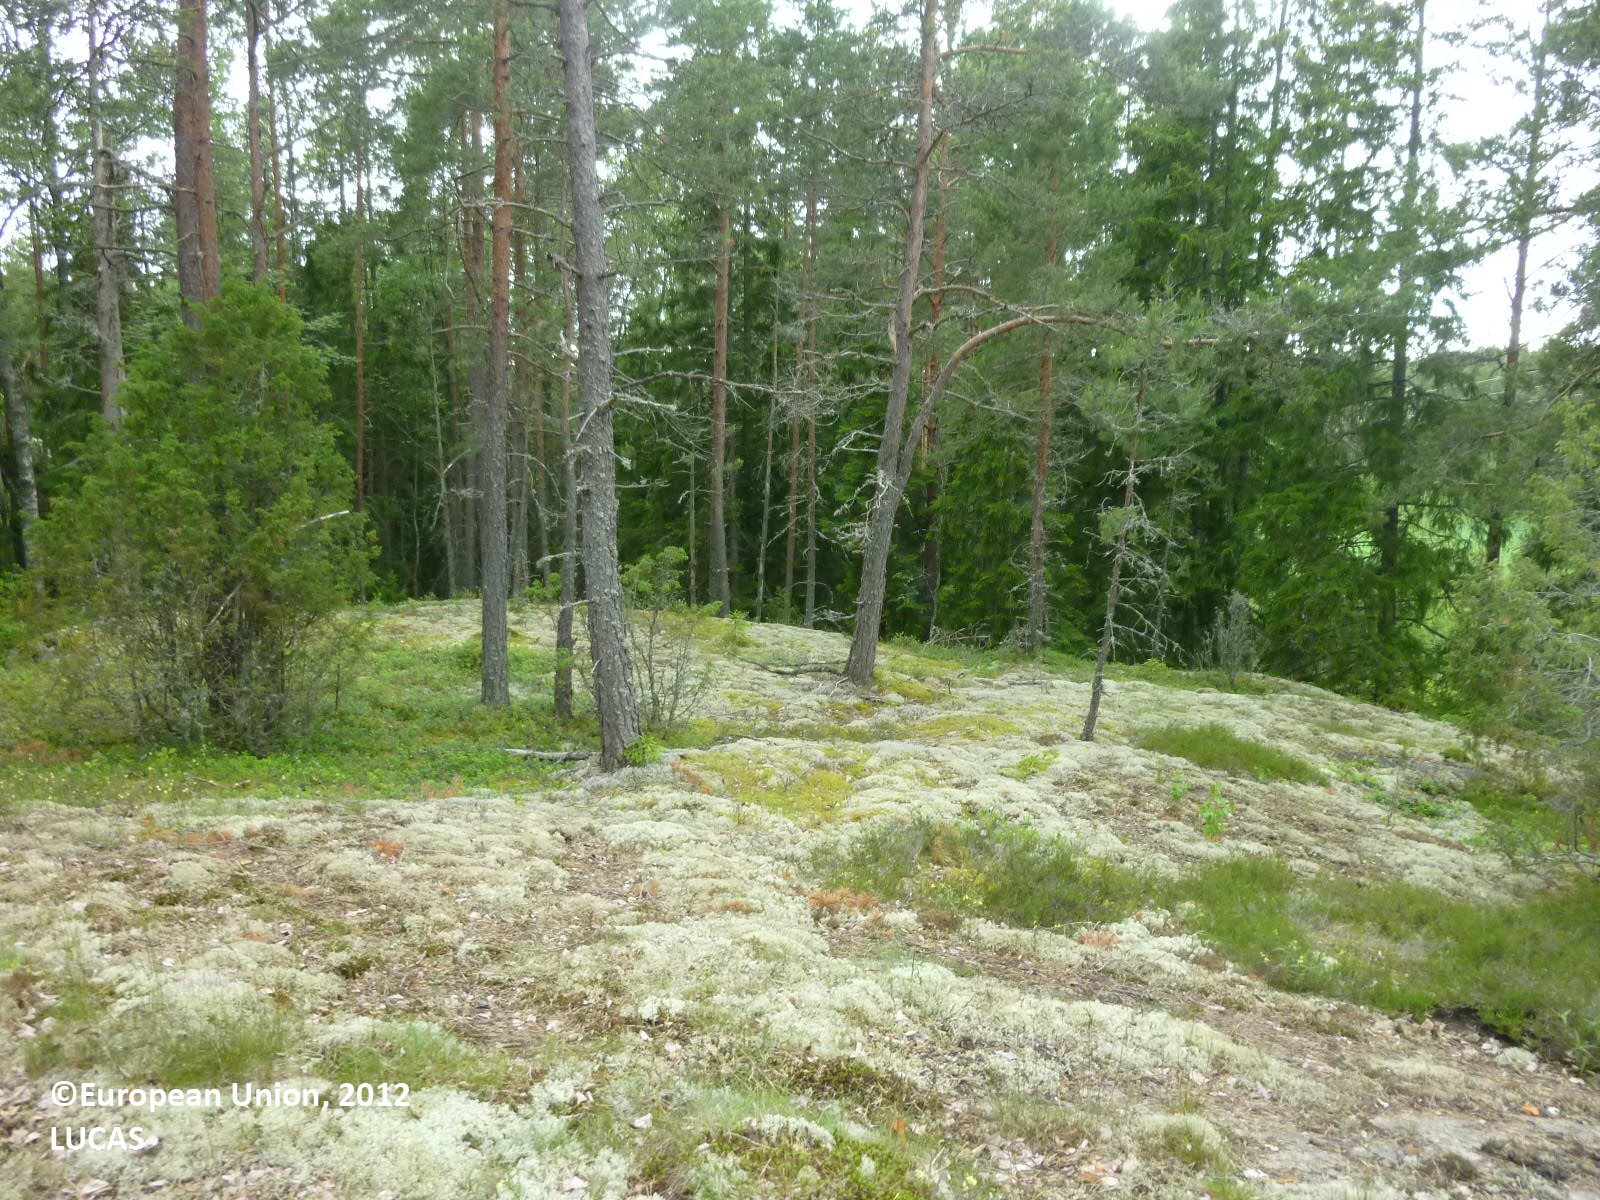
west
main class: Woodland
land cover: Pine dominated coniferous woodland
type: boreal forest
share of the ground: 10 - 25 %
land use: Forestry
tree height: > 5 m
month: June
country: FI
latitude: 60.2798
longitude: 22.4946
